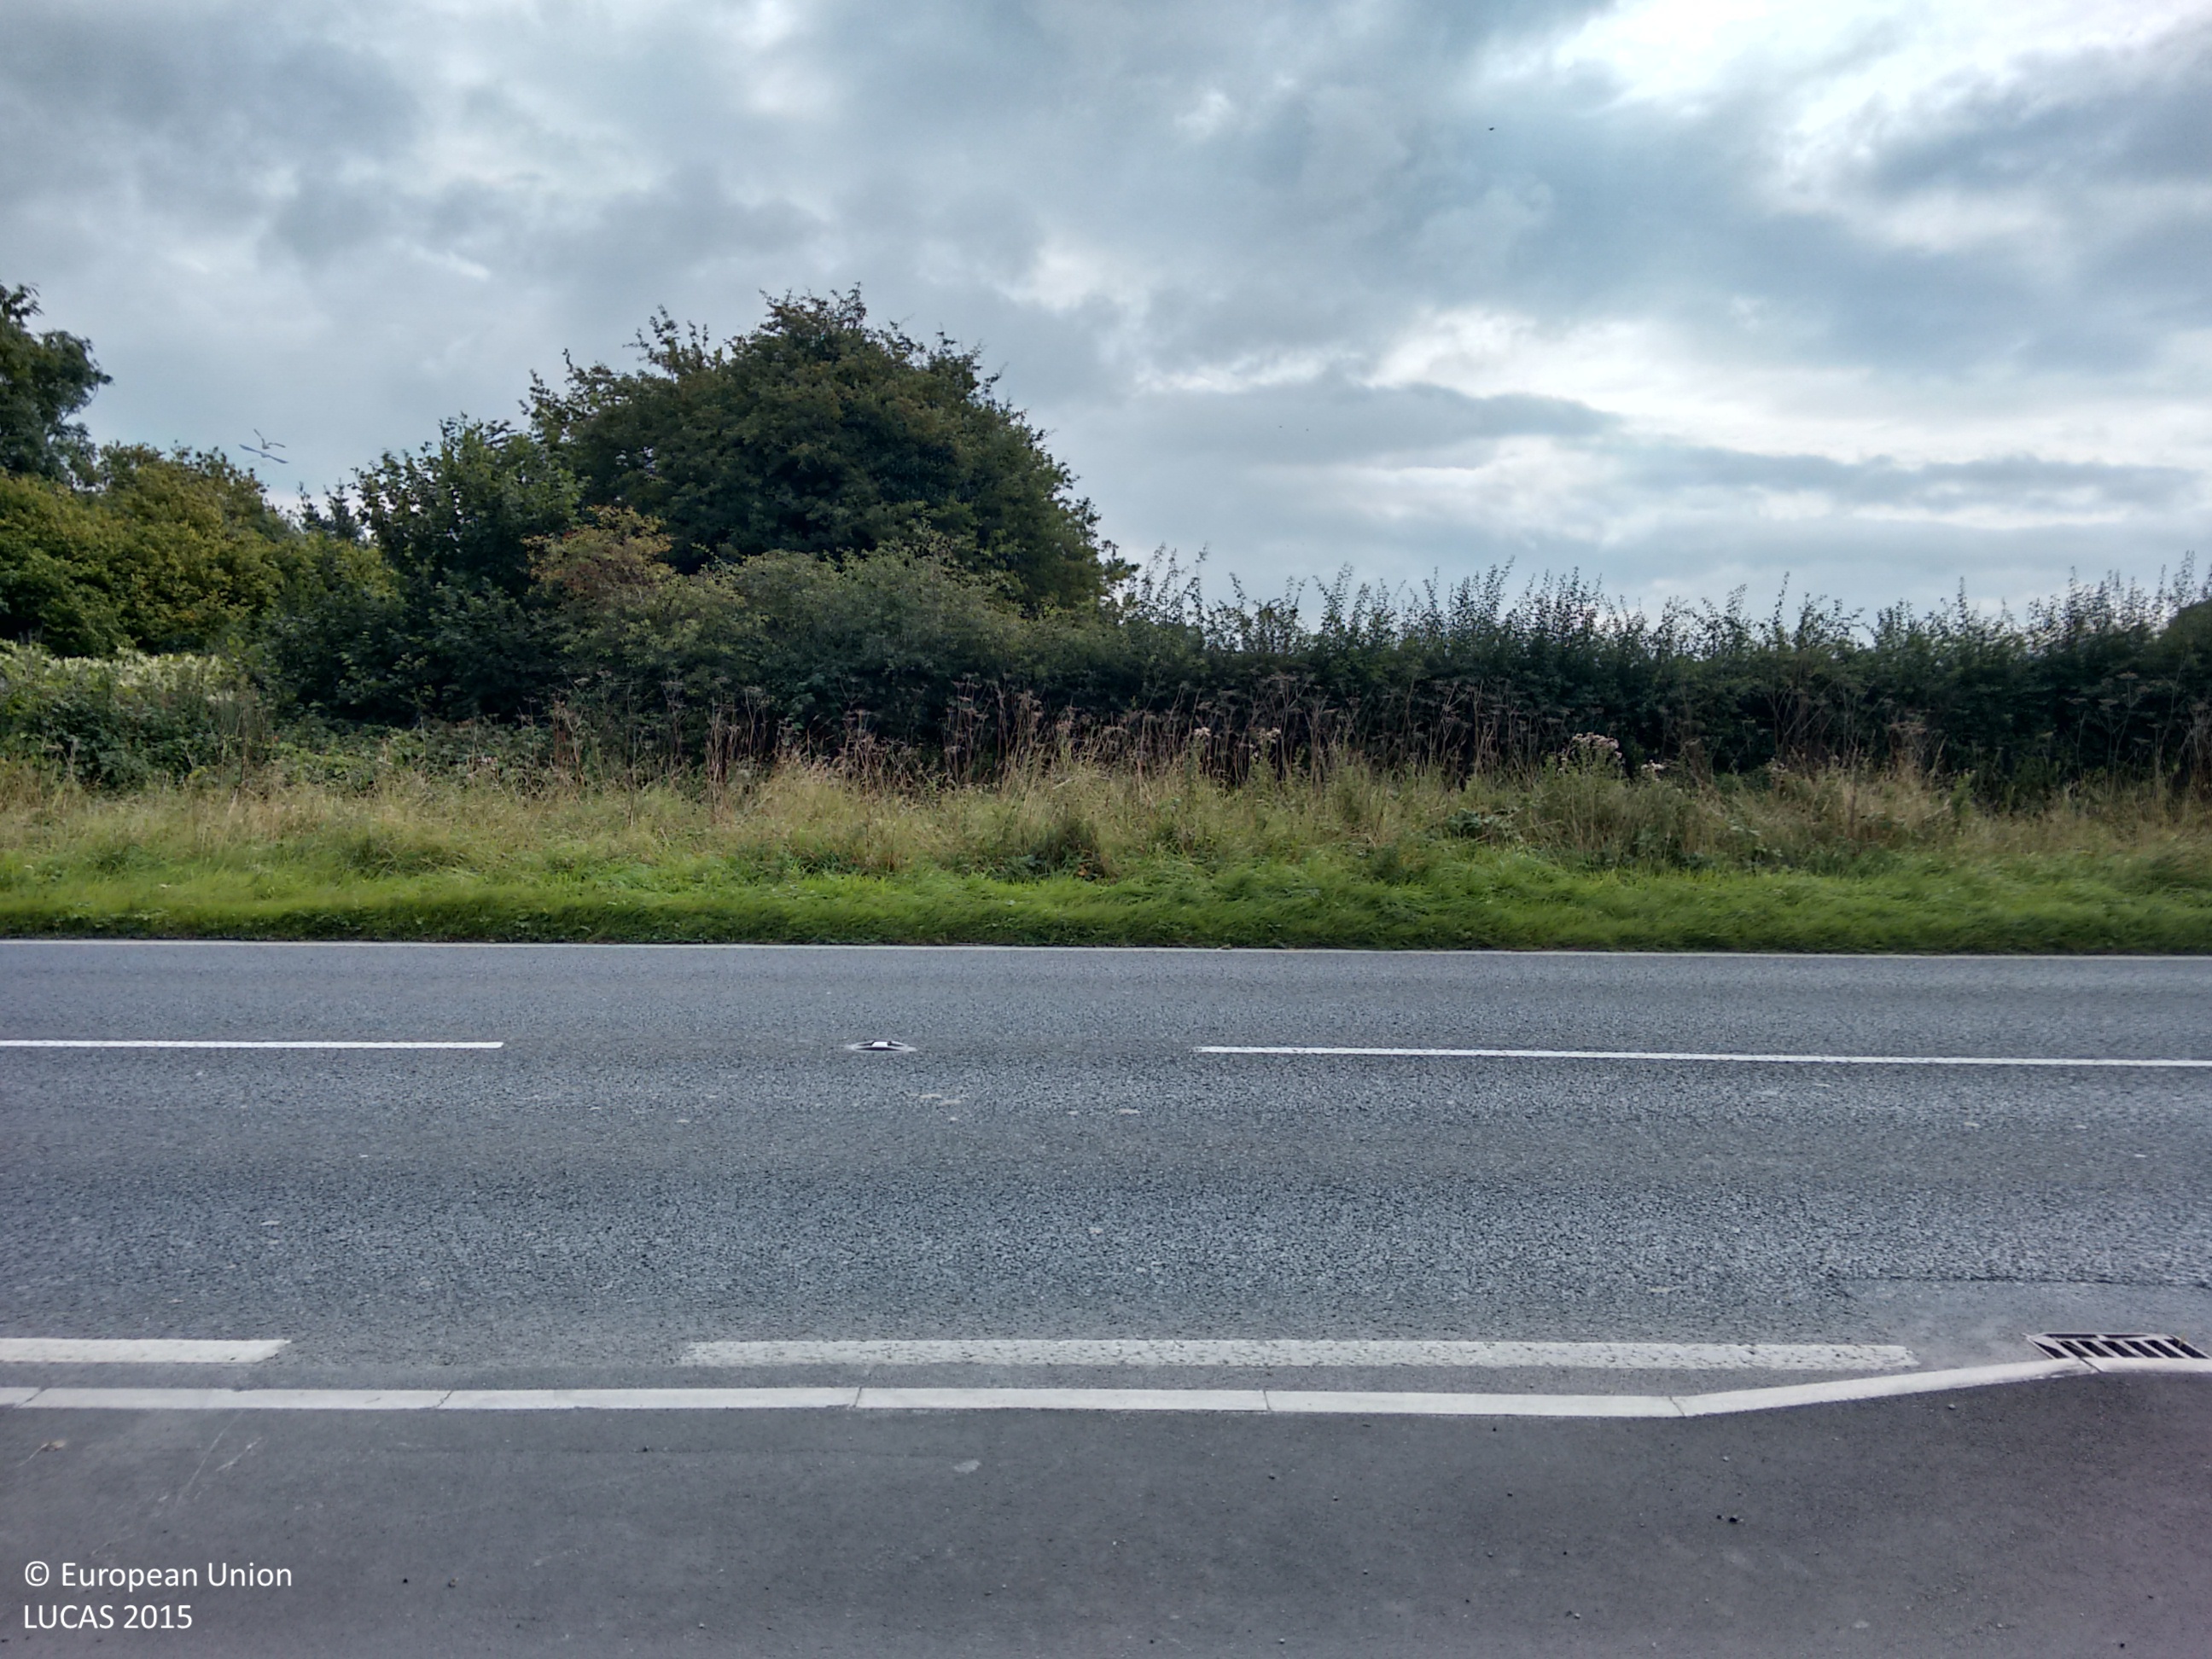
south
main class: Grassland
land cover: Grassland without tree/shrub cover
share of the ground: > 75 %
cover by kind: herbaceous plants 100 %
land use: Agriculture (excluding fallow land and kitchen gardens)
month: September
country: GB
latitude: 52.1108
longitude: -4.5778
